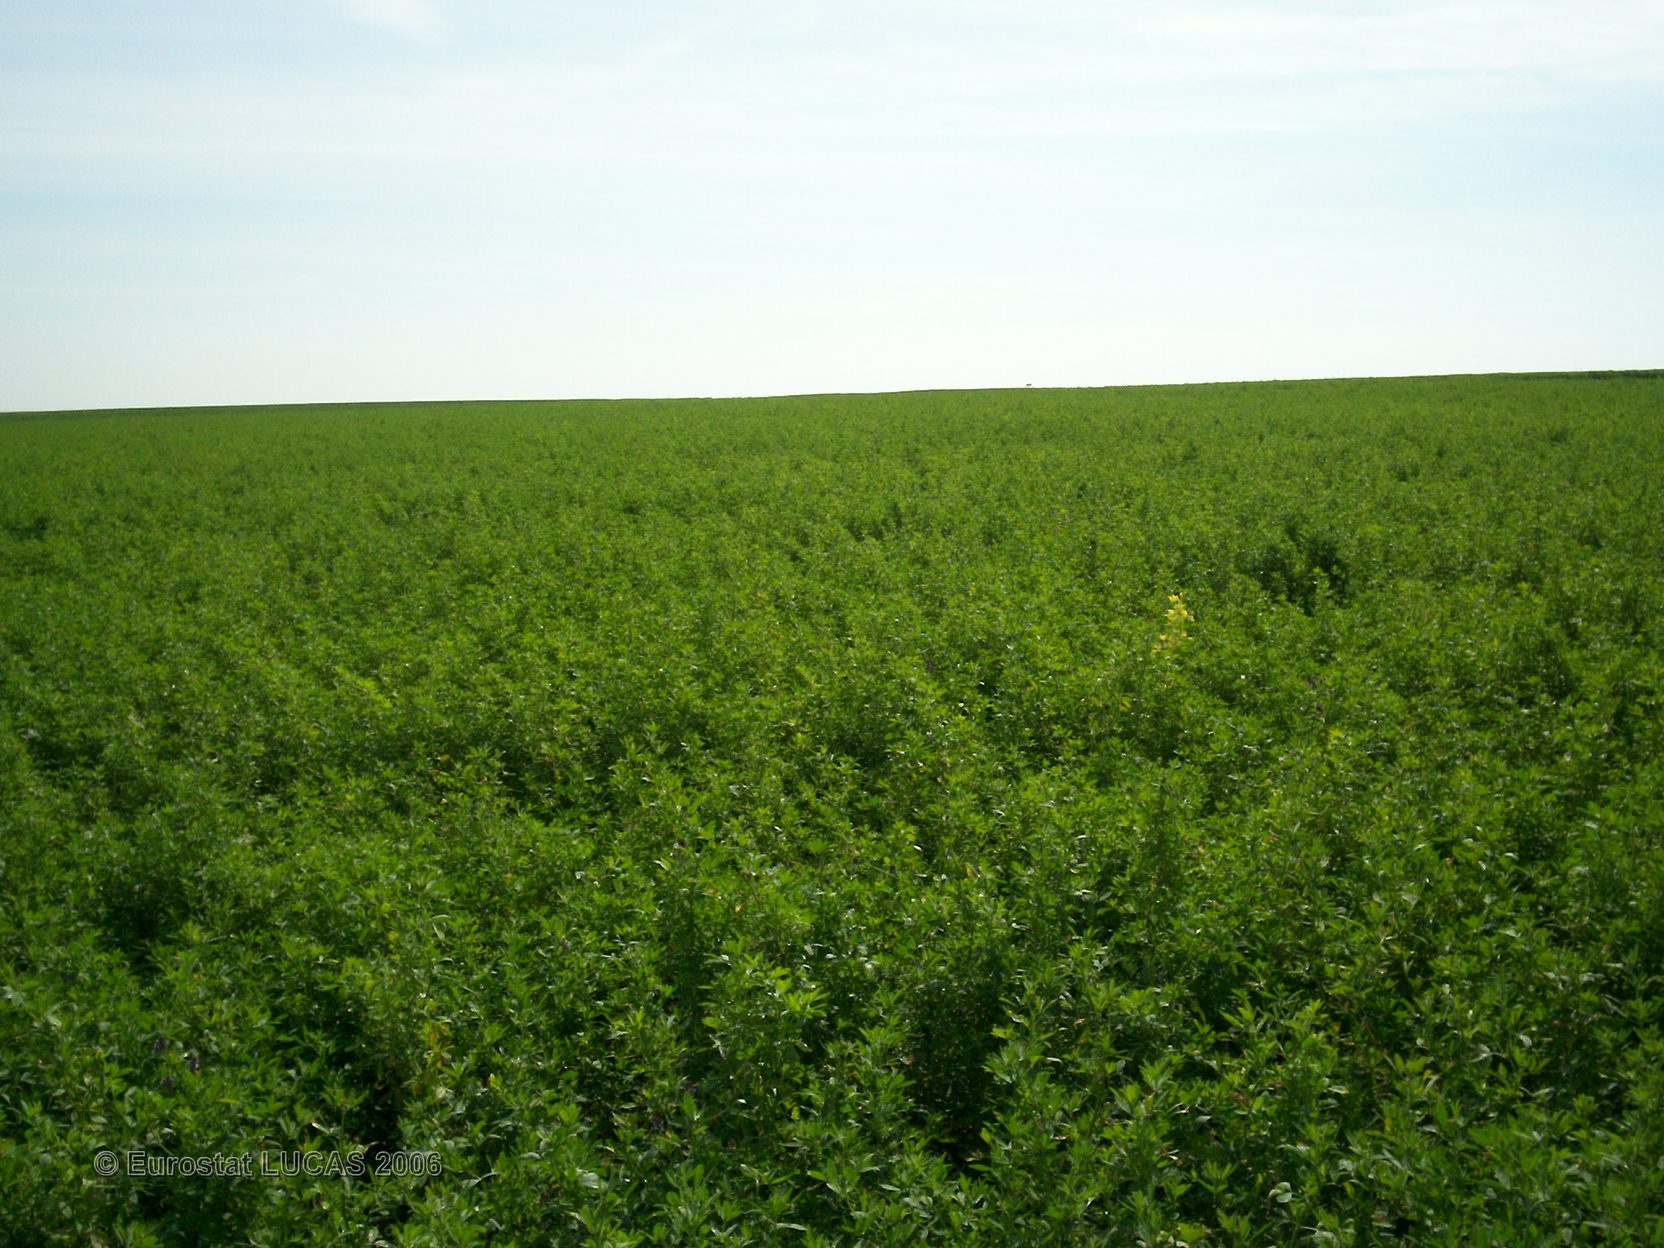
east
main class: Cropland
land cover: Lucerne
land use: Agriculture (excluding fallow land and kitchen gardens)
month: June
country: FR
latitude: 48.9502
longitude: 4.4662
